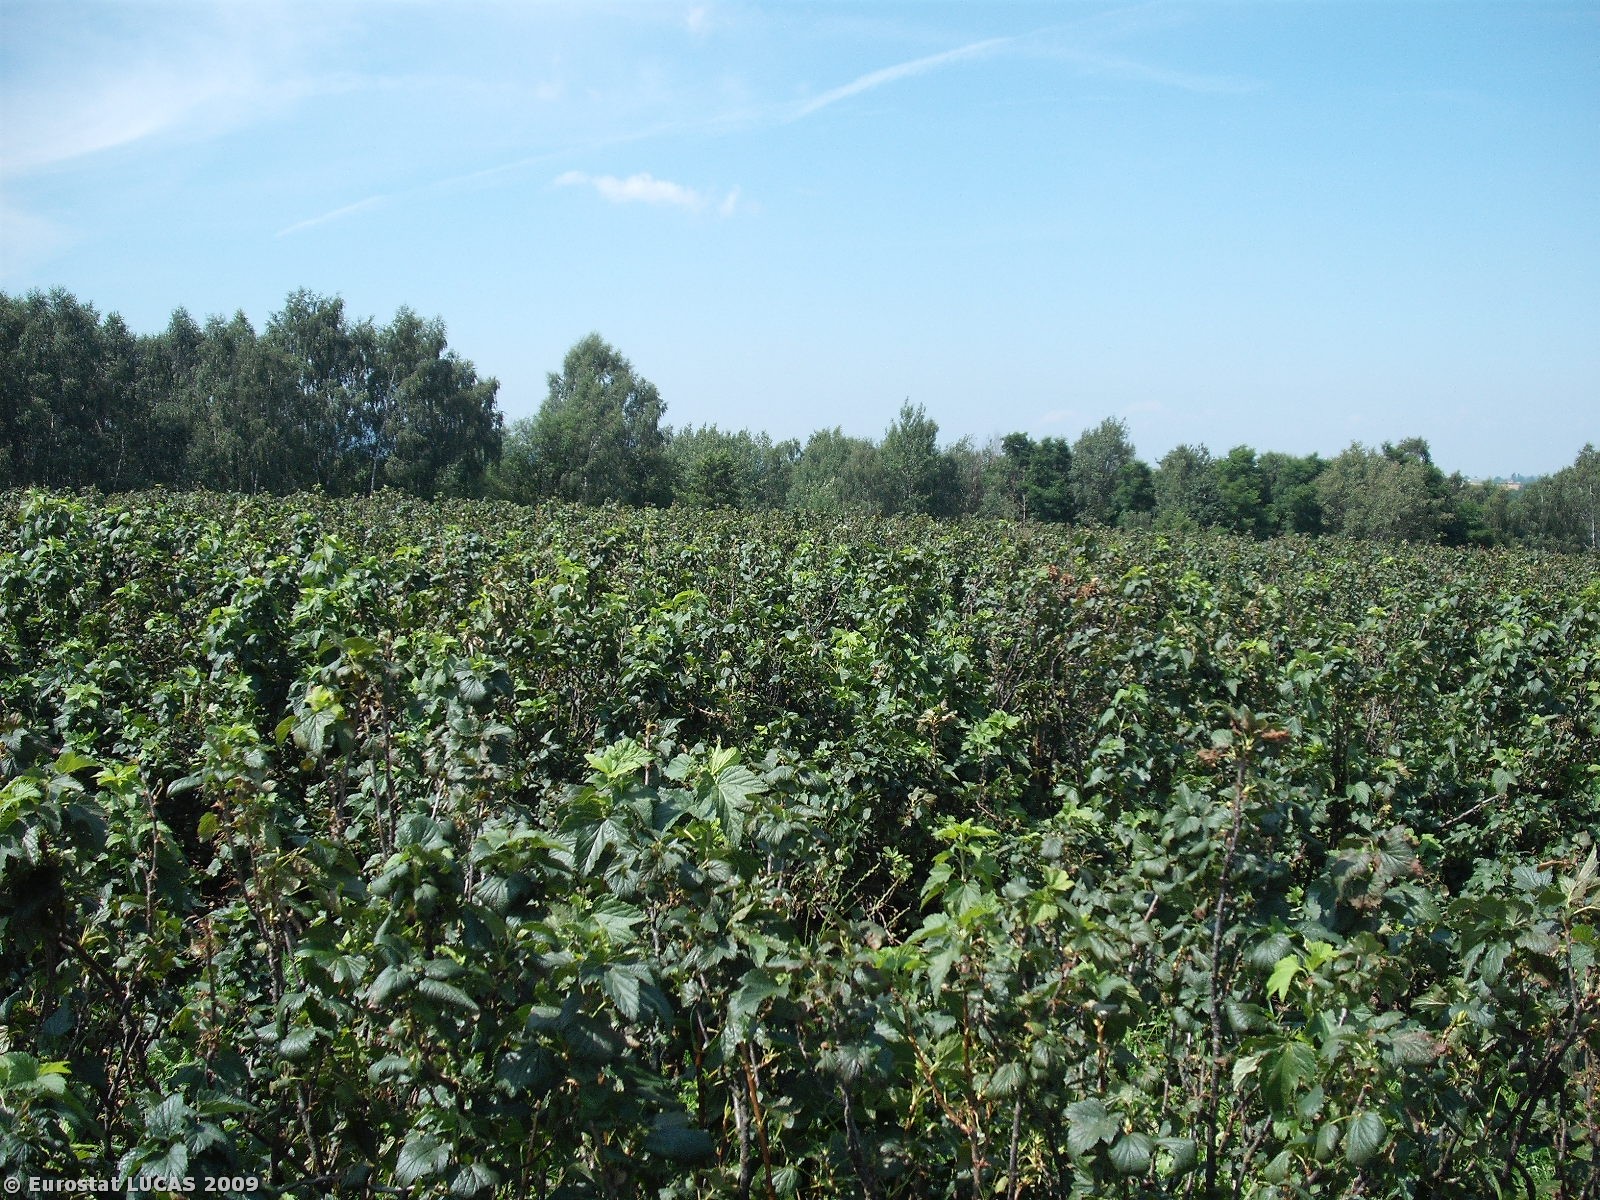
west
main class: Cropland
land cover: Common wheat
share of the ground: > 75 %
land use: Agriculture (excluding fallow land and kitchen gardens)
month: July
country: PL
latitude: 50.8391
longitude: 21.2806
